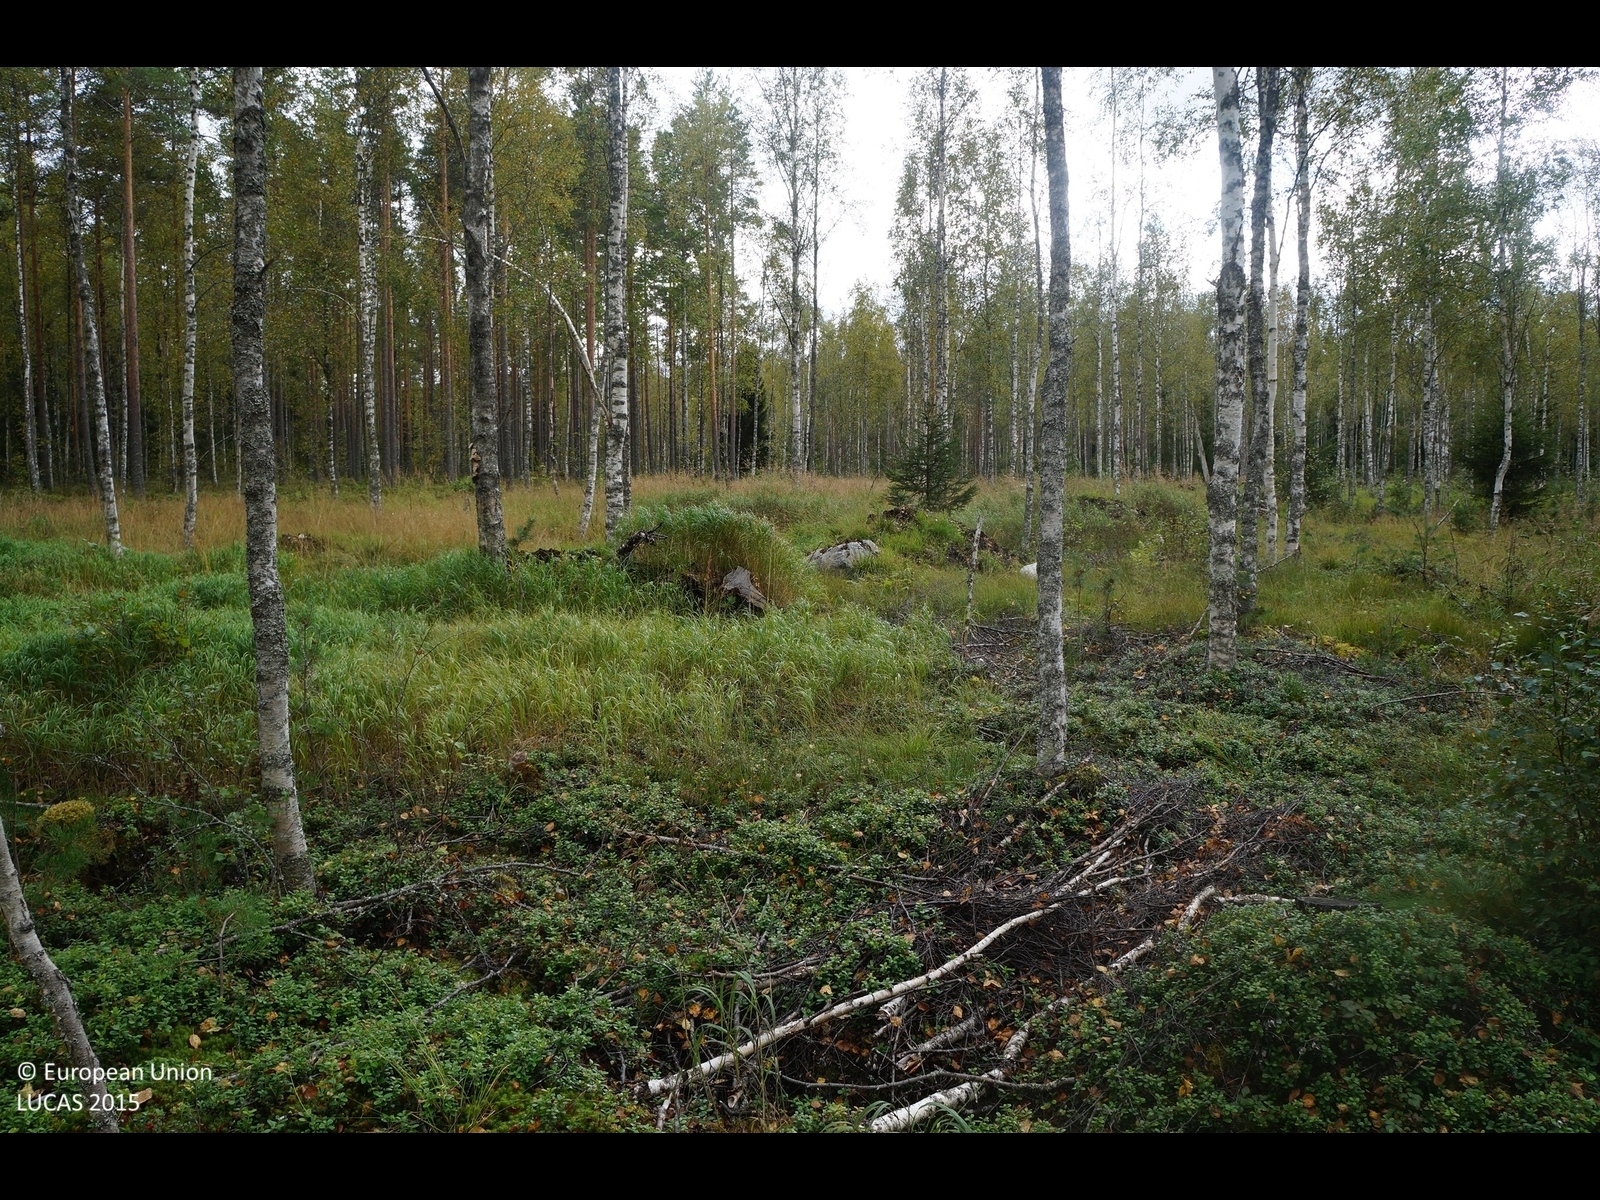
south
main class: Woodland
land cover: Broadleaved woodland
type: non-riverine alder, birch or aspen forest
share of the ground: 50 - 75 %
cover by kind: broadleaved forest trees 50 %, shrubs 20 %, herbaceous plants 20 %, lichens and mosses 10 %
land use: Forestry
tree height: > 5 m
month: September
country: FI
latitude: 64.0370
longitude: 24.3408
